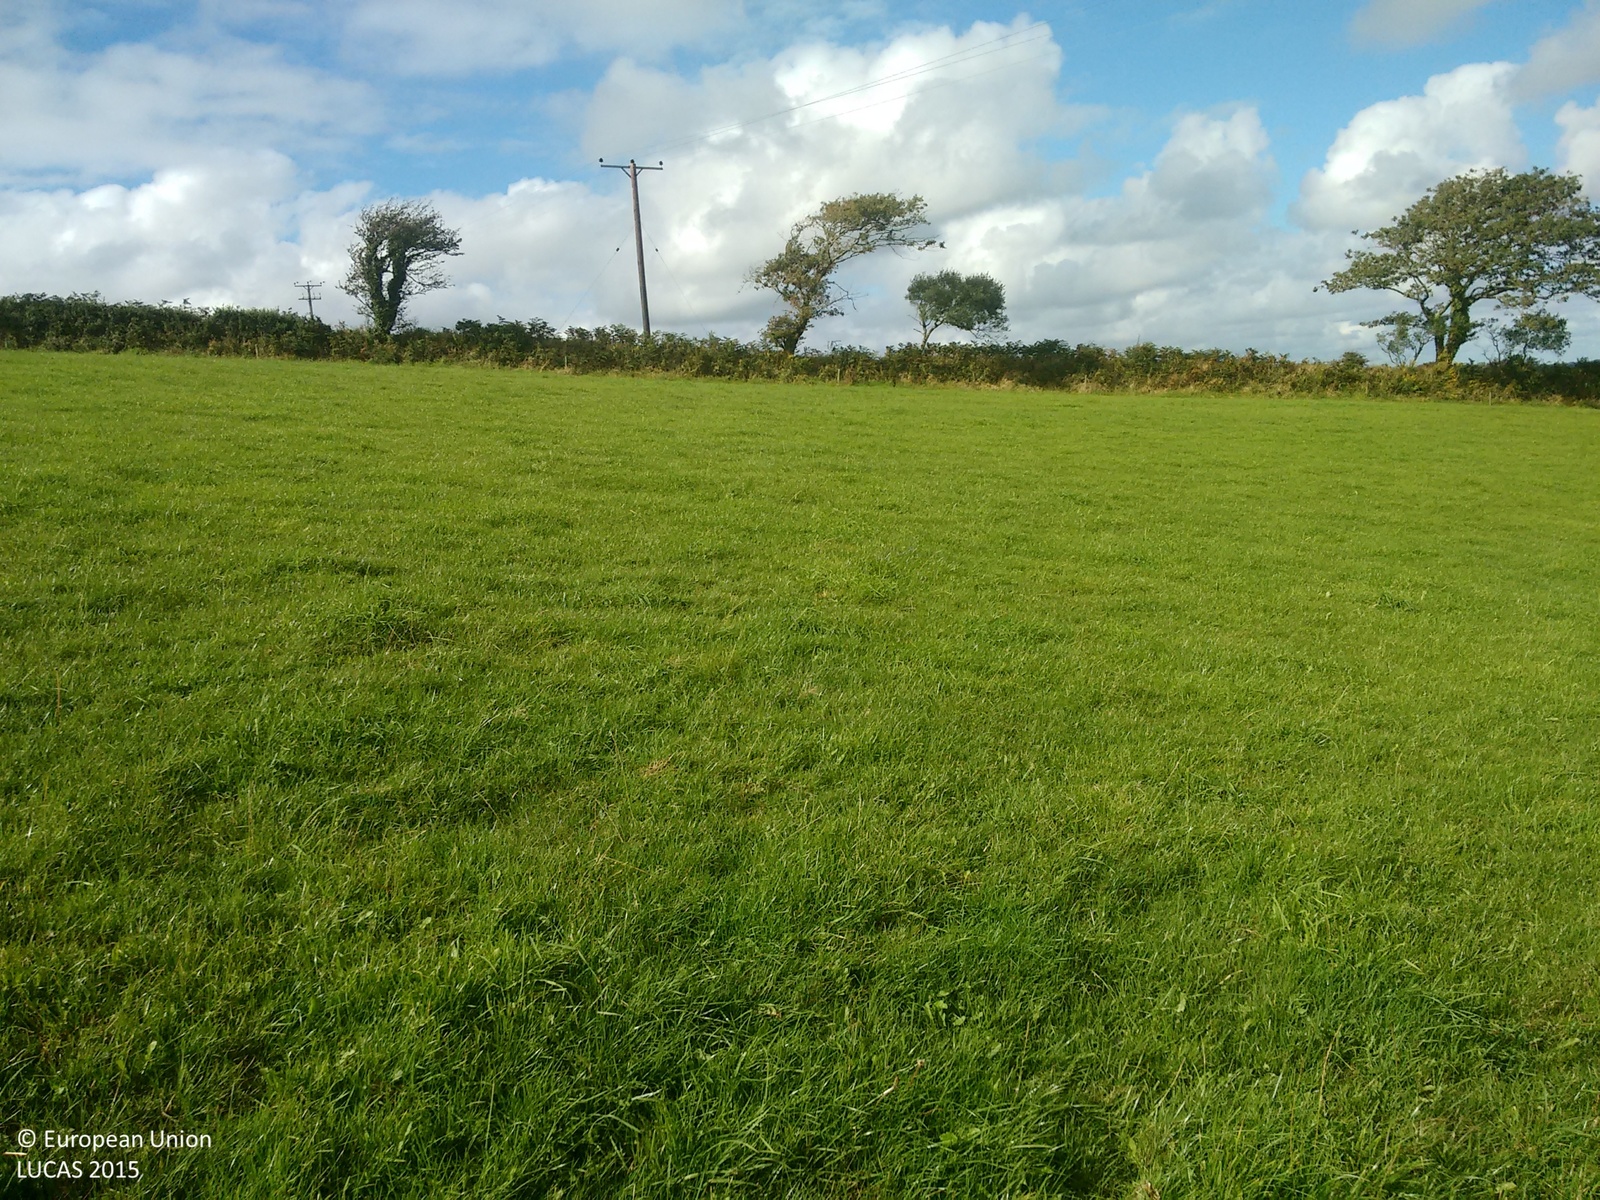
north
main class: Grassland
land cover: Grassland without tree/shrub cover
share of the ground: > 75 %
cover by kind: herbaceous plants 100 %
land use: Agriculture (excluding fallow land and kitchen gardens)
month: September
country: GB
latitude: 50.2031
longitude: -5.1810
